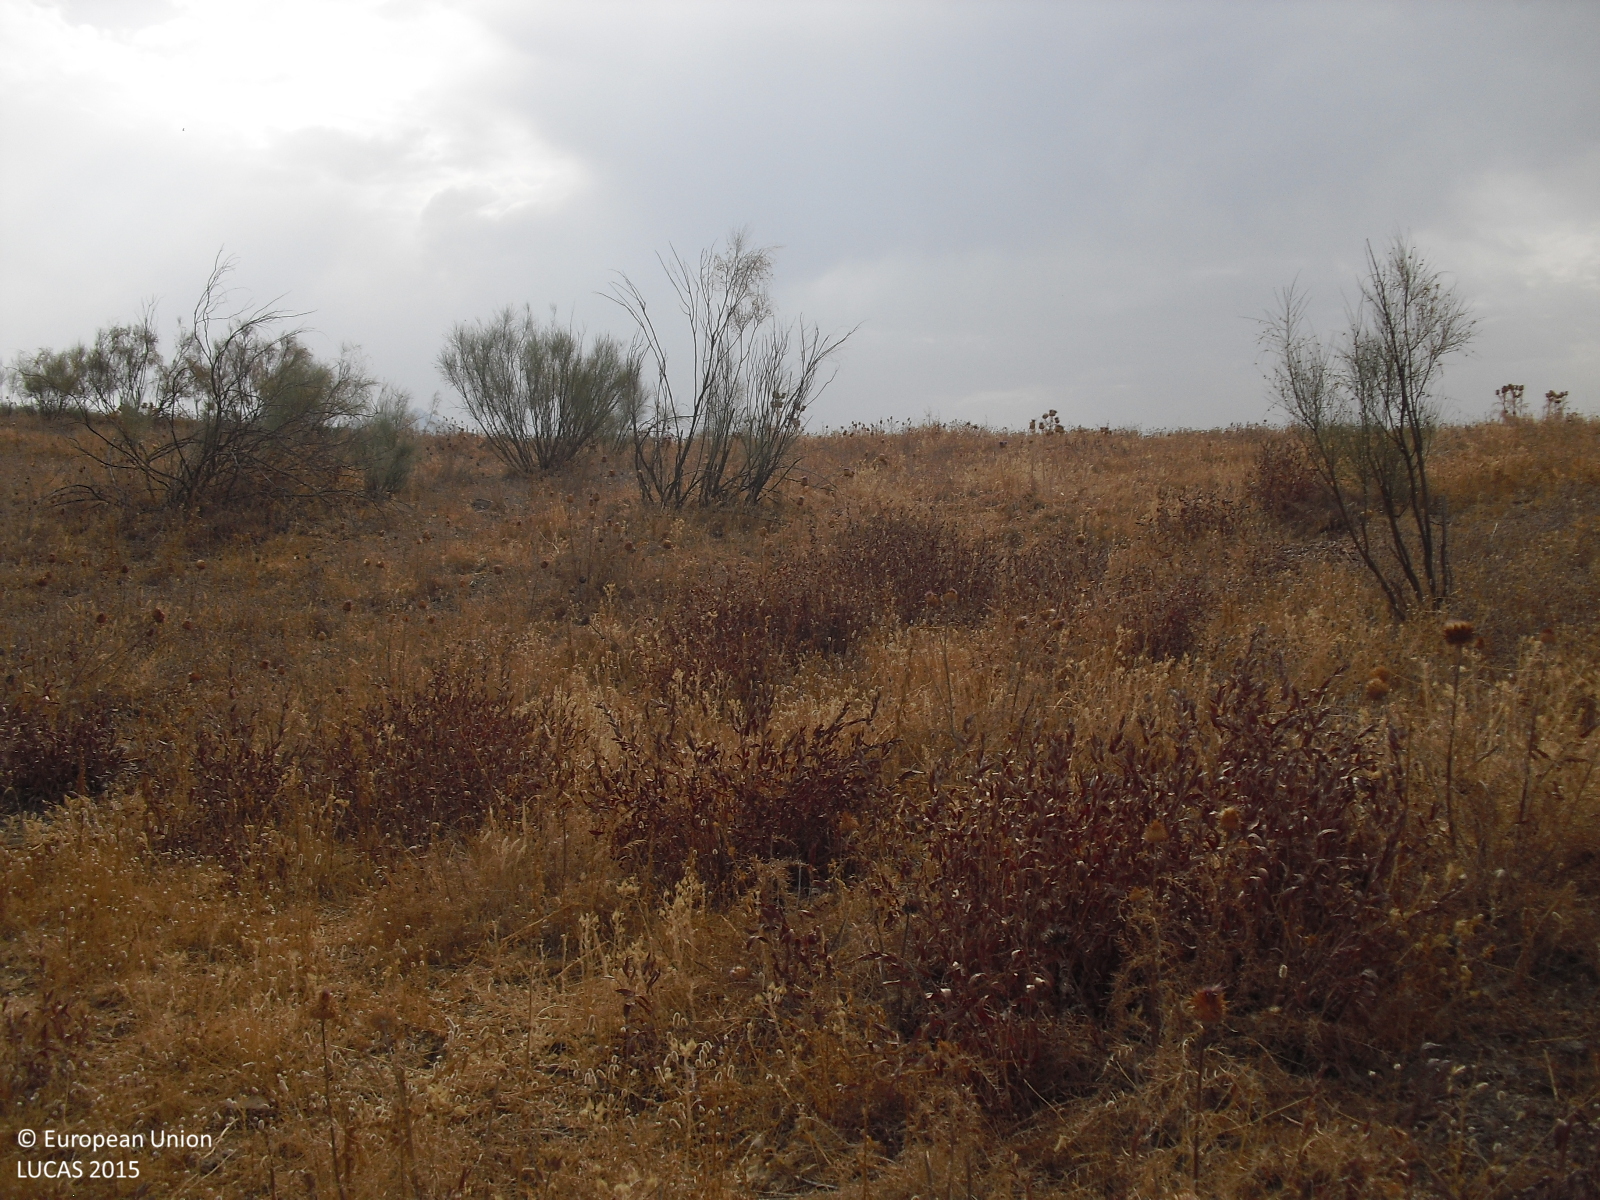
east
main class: Shrubland
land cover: Shrubland without tree cover
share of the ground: 10 - 25 %
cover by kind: herbaceous plants 75 %, shrubs 15 %, unconsolidated bare surface 10 %
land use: Semi-natural and natural areas not in use
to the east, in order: Shrubland without tree cover; Tracks; Shrubland without tree cover; Other structural elements; Shrubland without tree cover
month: August
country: ES
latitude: 37.3205
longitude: -4.4334
